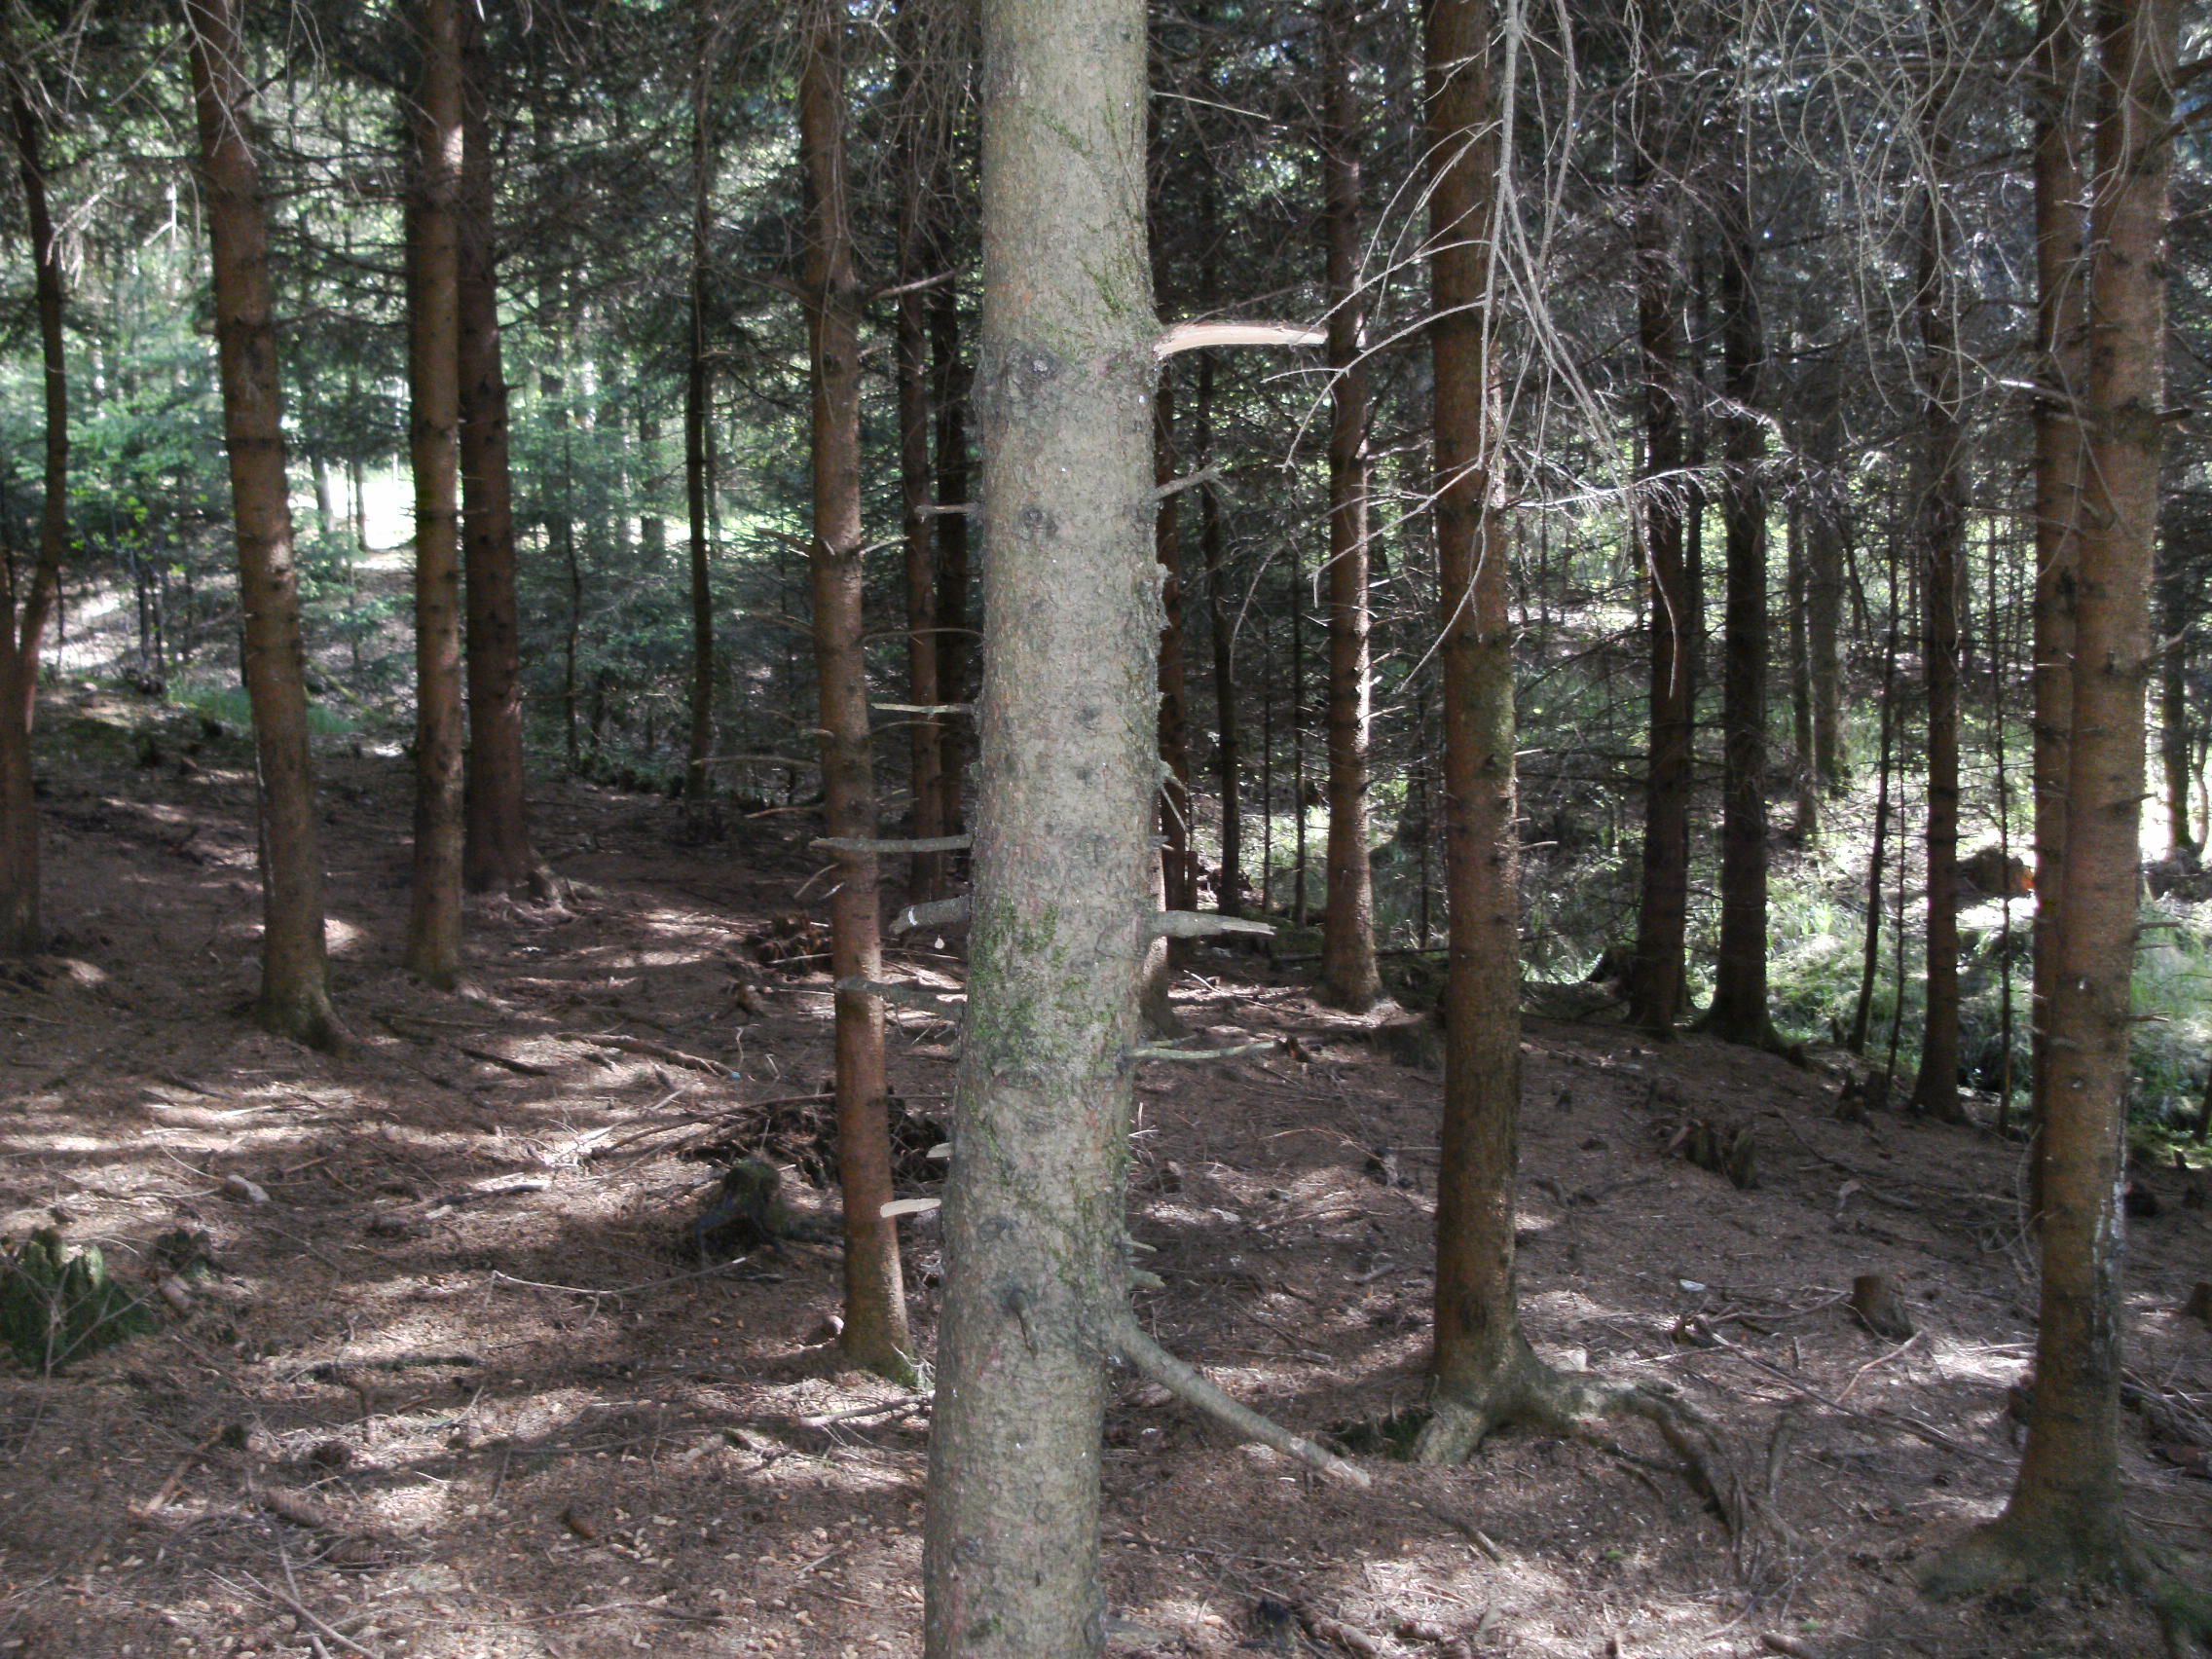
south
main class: Woodland
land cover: Spruce dominated coniferous woodland
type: hemiboreal forest and nemoral coniferous forest and mixed broadleaved-coniferous forest
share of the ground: > 75 %
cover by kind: coniferous forest trees 100 %
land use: Forestry
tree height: > 5 m
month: May
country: AT
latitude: 48.4364
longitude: 13.5544
